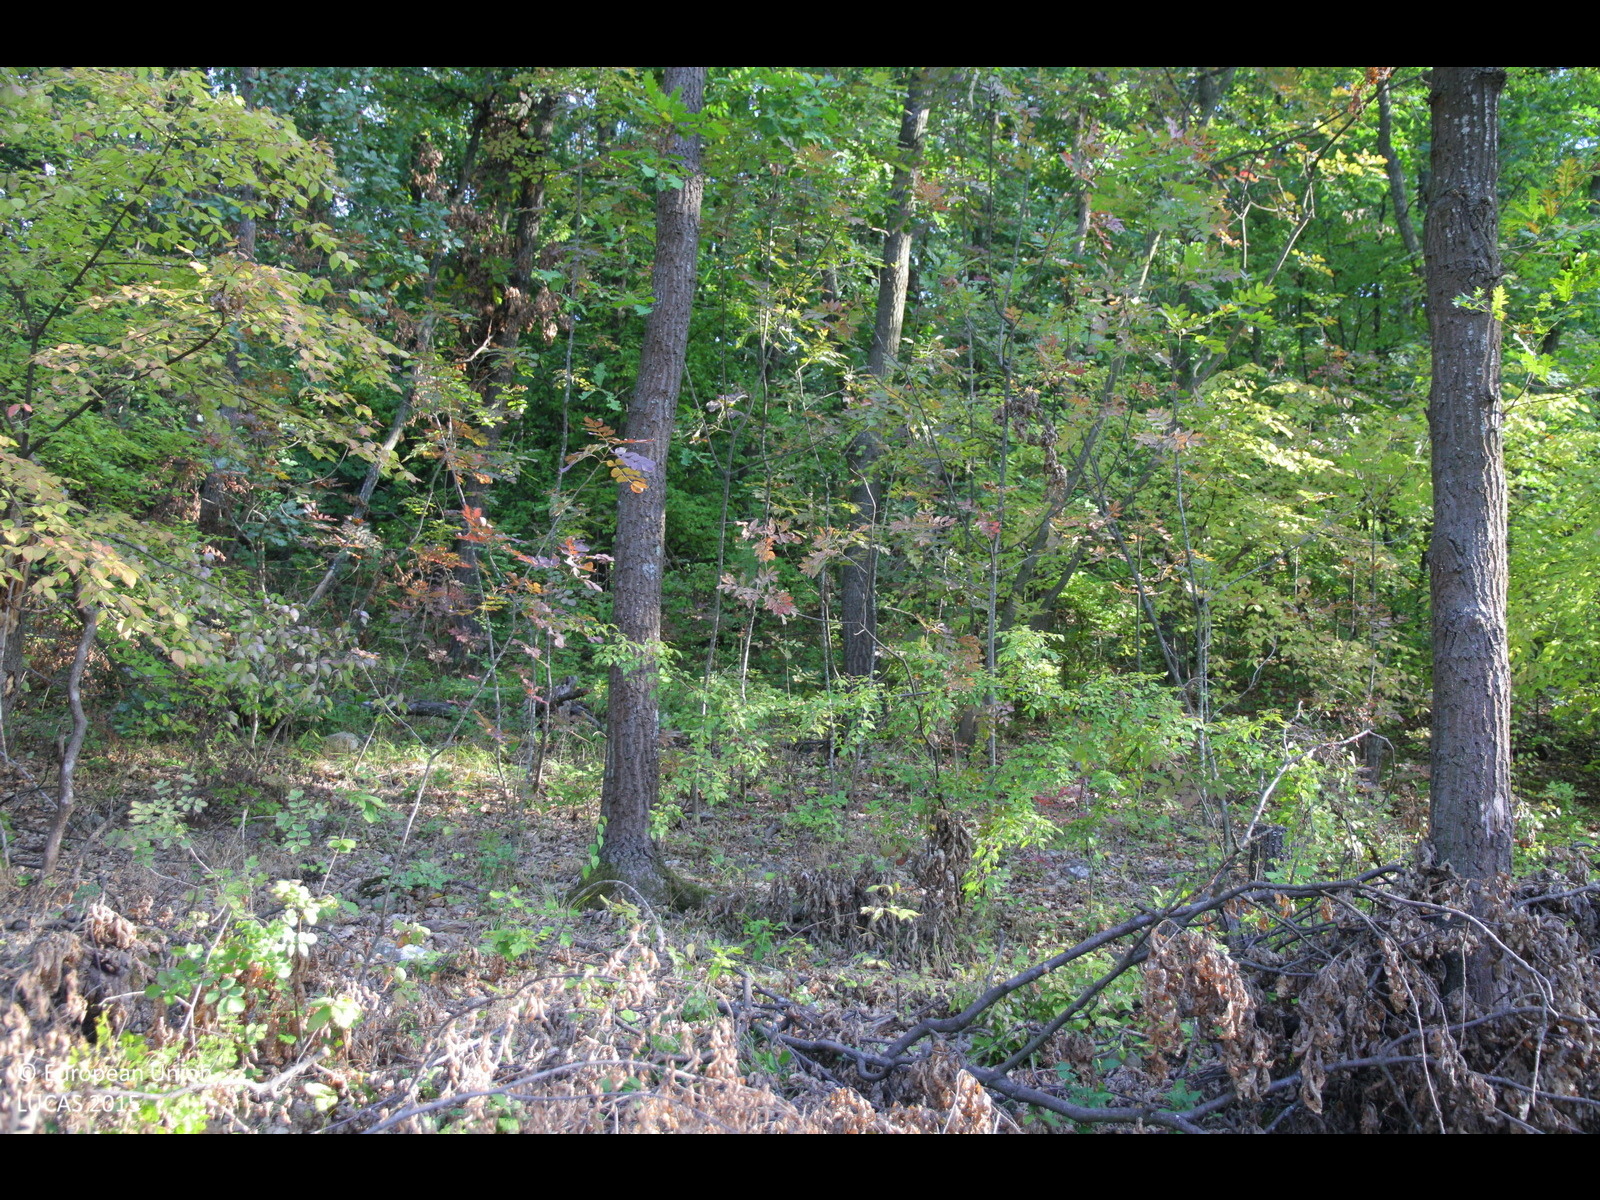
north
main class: Woodland
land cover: Broadleaved woodland
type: acidophilous oak and oak-birch forest
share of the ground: 50 - 75 %
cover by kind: broadleaved forest trees 70 %, unconsolidated bare surface 15 %, herbaceous plants 10 %, shrubs 5 %
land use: Forestry
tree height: > 5 m
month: October
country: BG
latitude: 43.3730
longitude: 27.2401
